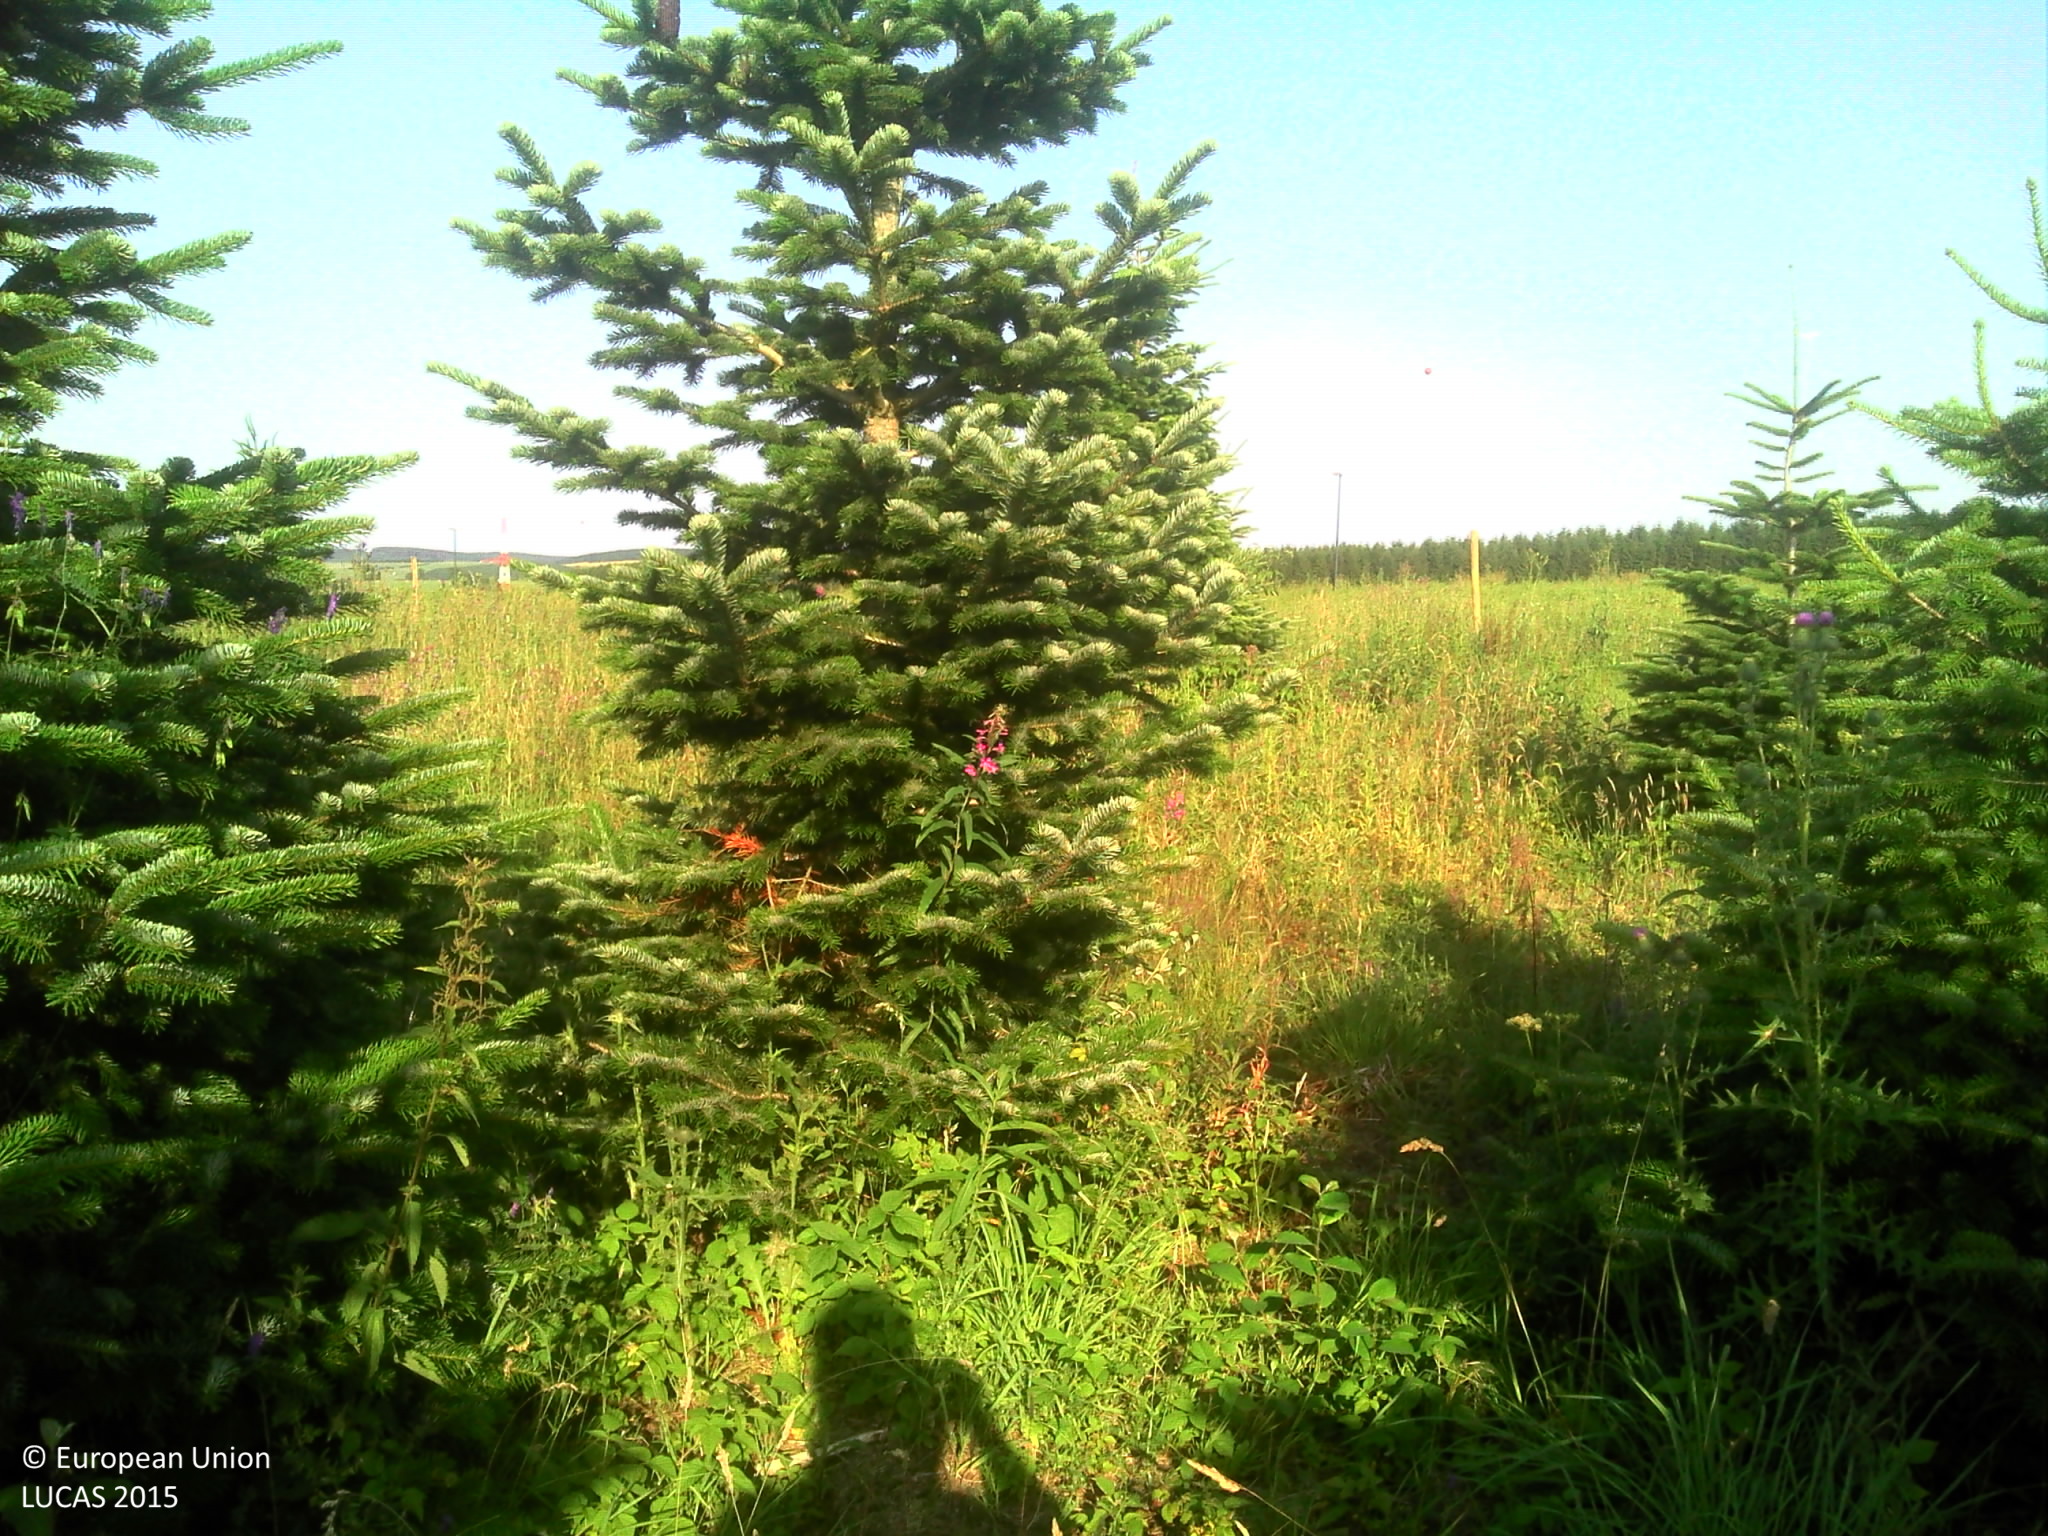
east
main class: Cropland
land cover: Nurseries
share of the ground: > 75 %
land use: Forestry
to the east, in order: Nurseries; Spontaneously vegetated surfaces; Tracks; Nurseries; Spontaneously vegetated surfaces; Nurseries; Tracks; Nurseries; Tracks; Nurseries; Grassland without tree/shrub cover
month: July
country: BE
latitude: 49.8996
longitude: 5.5573
